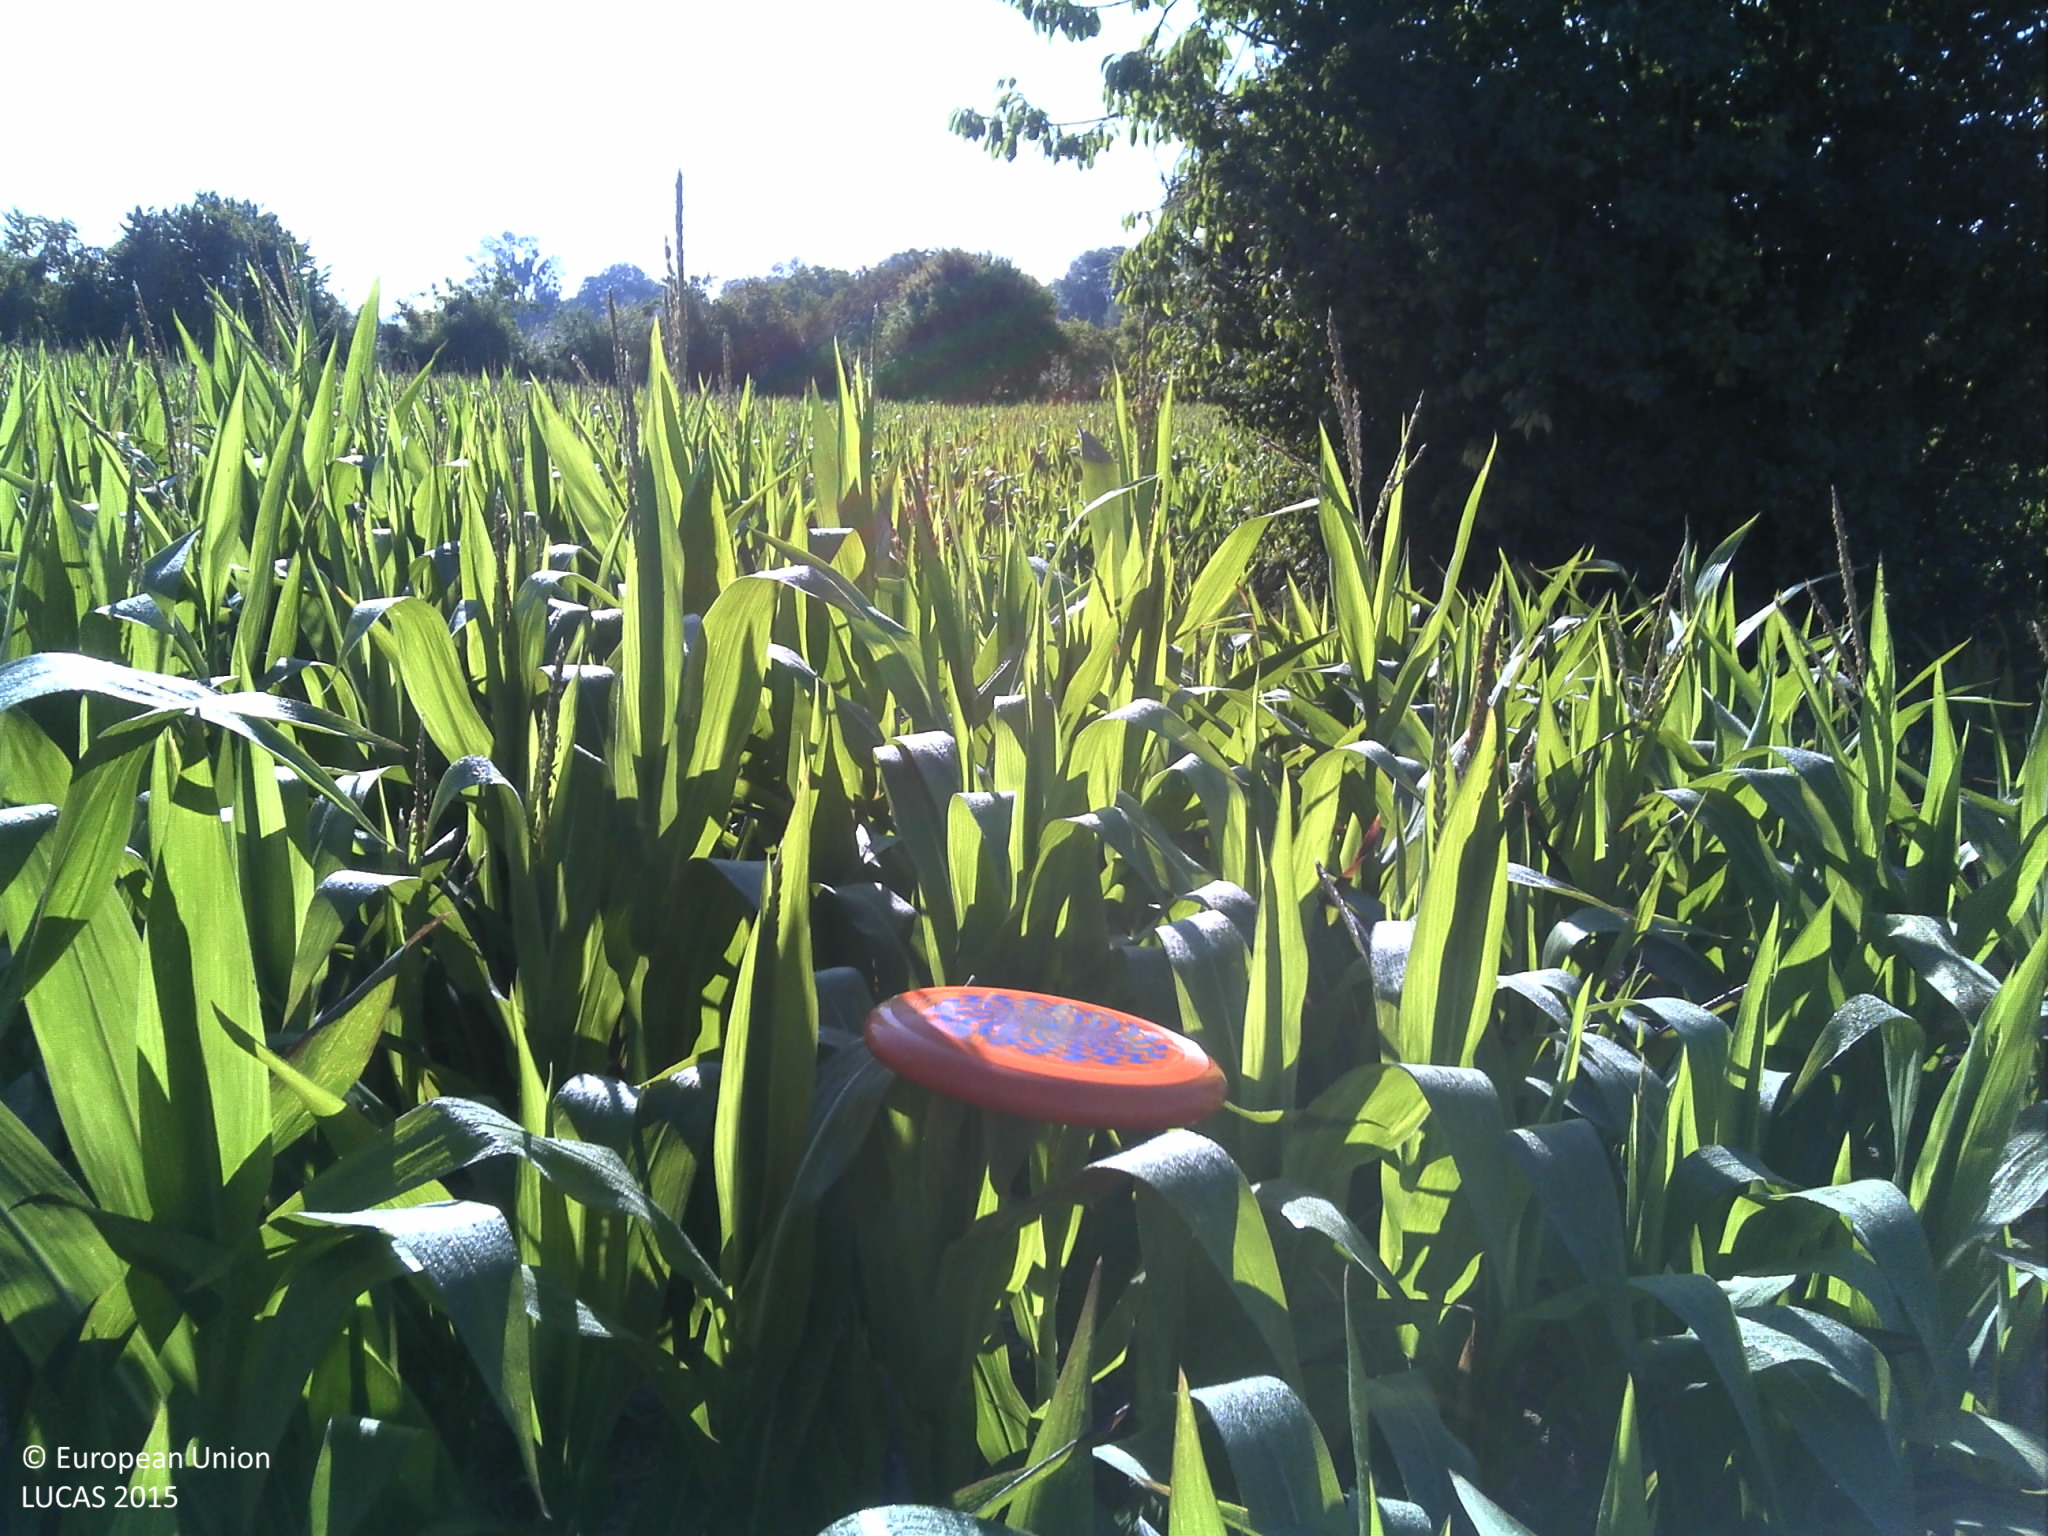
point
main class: Cropland
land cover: Maize
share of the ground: 50 - 75 %
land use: Agriculture (excluding fallow land and kitchen gardens)
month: August
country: FR
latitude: 49.1043
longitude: 4.6687
